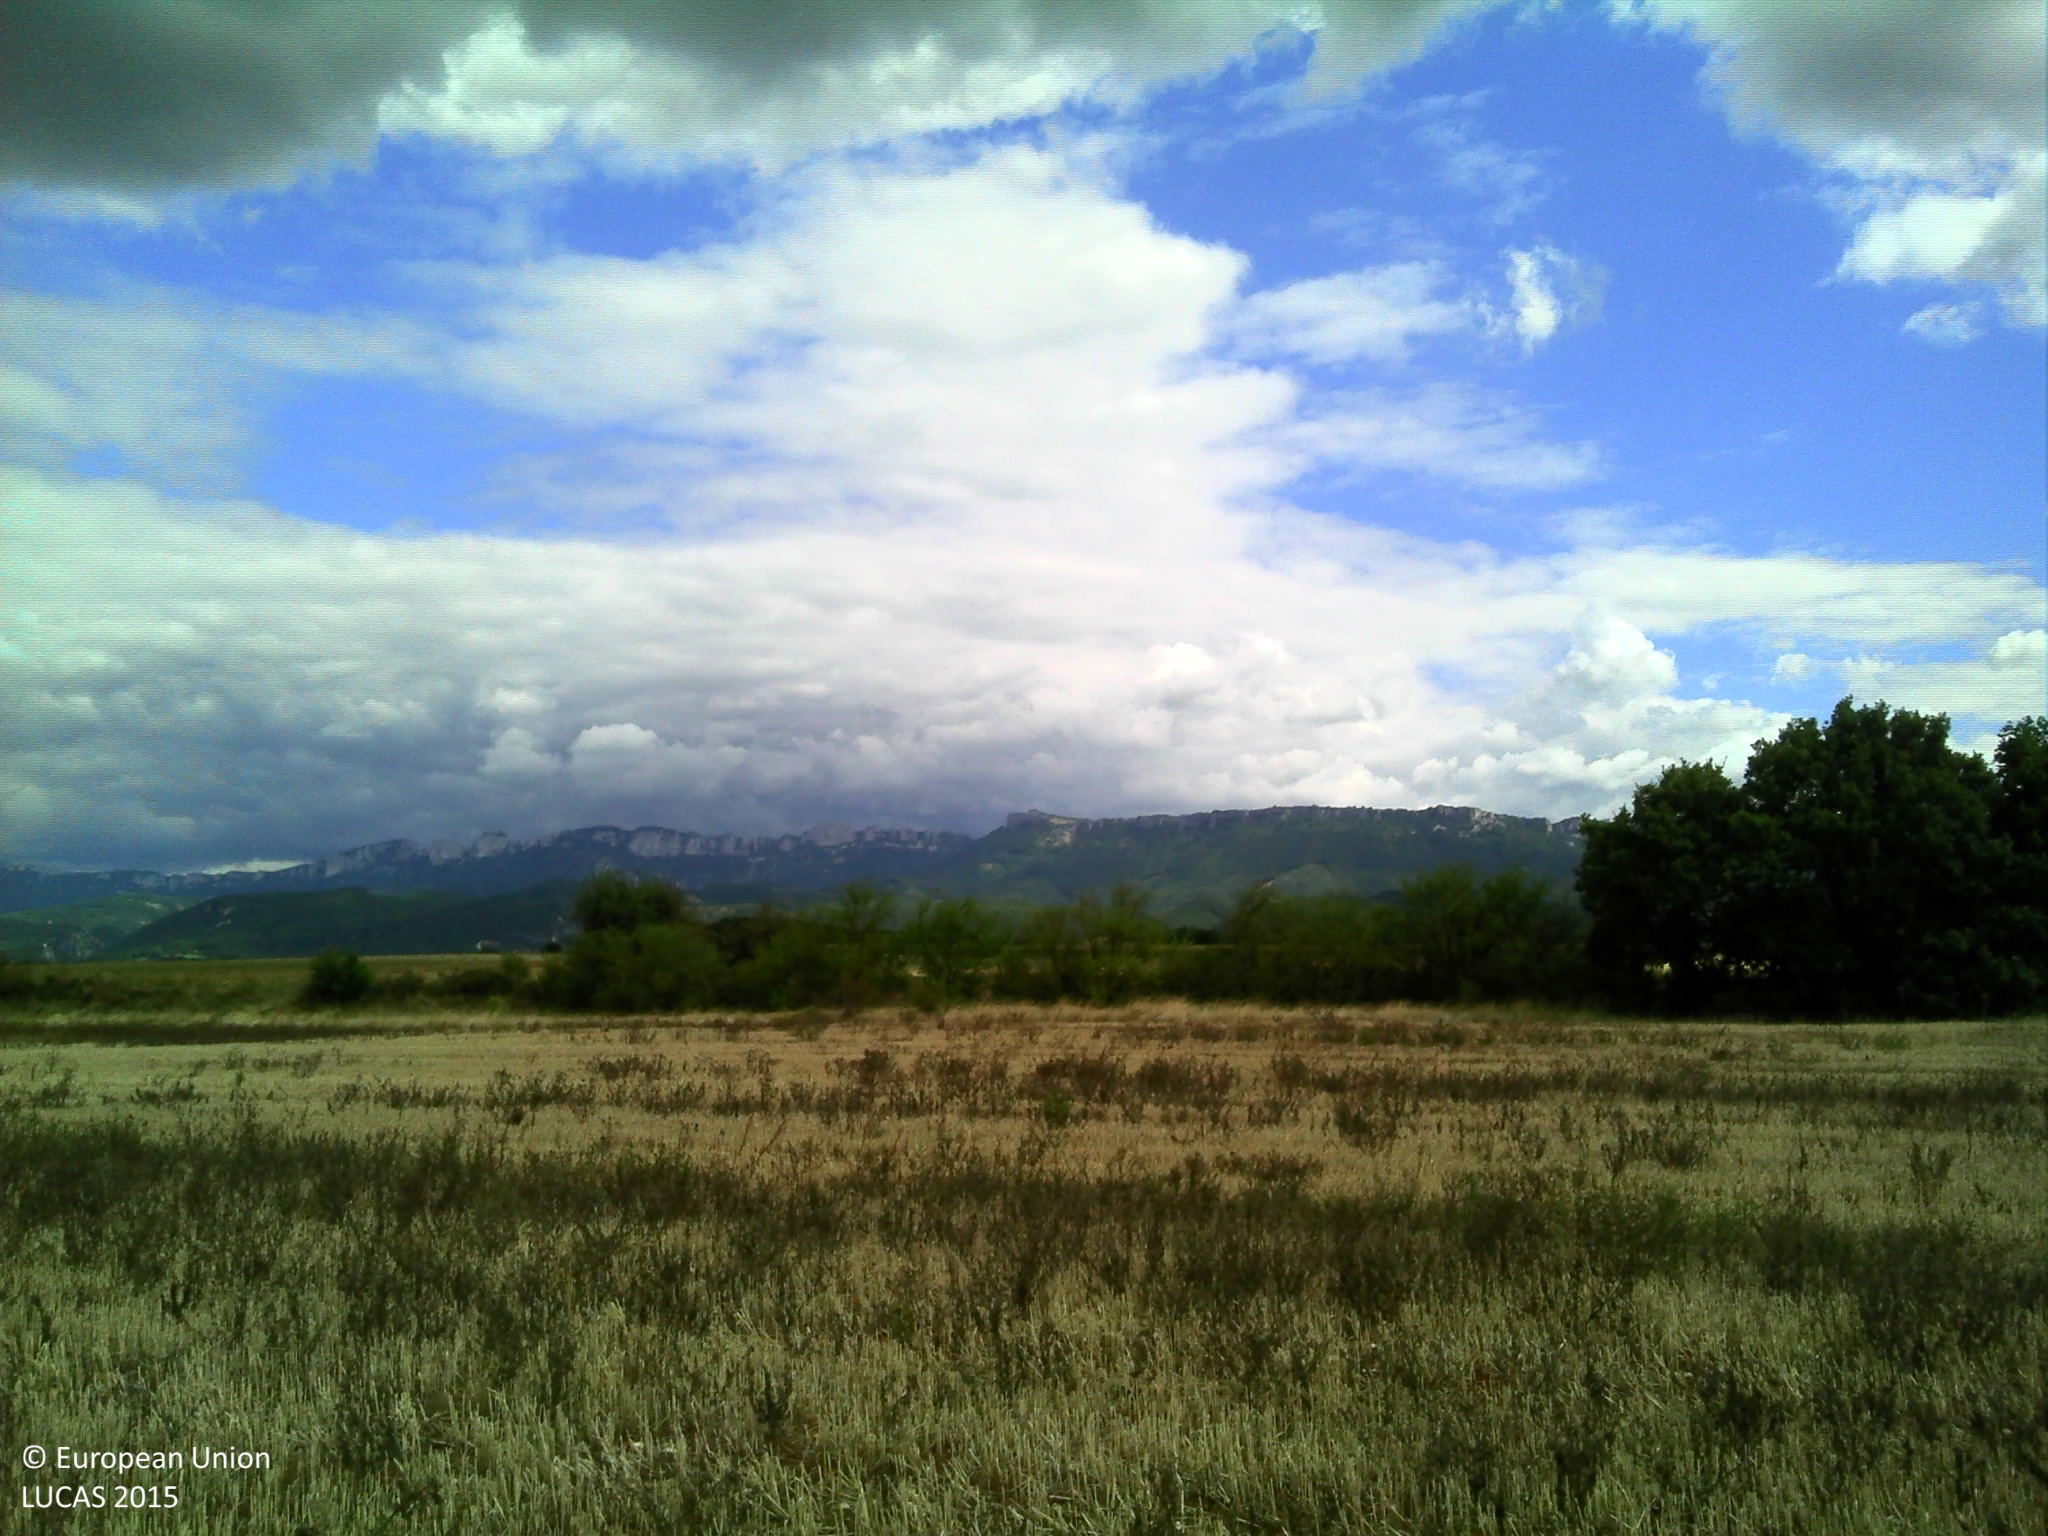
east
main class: Cropland
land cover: Common wheat
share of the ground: > 75 %
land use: Agriculture (excluding fallow land and kitchen gardens)
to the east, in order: Common wheat; Grass margins; Lines of trees; Ditches and canals; Paved roads, cycling and walking lanes; Ditches and canals; Lines of trees; Common wheat
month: September
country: FR
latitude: 44.9370
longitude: 5.0511
